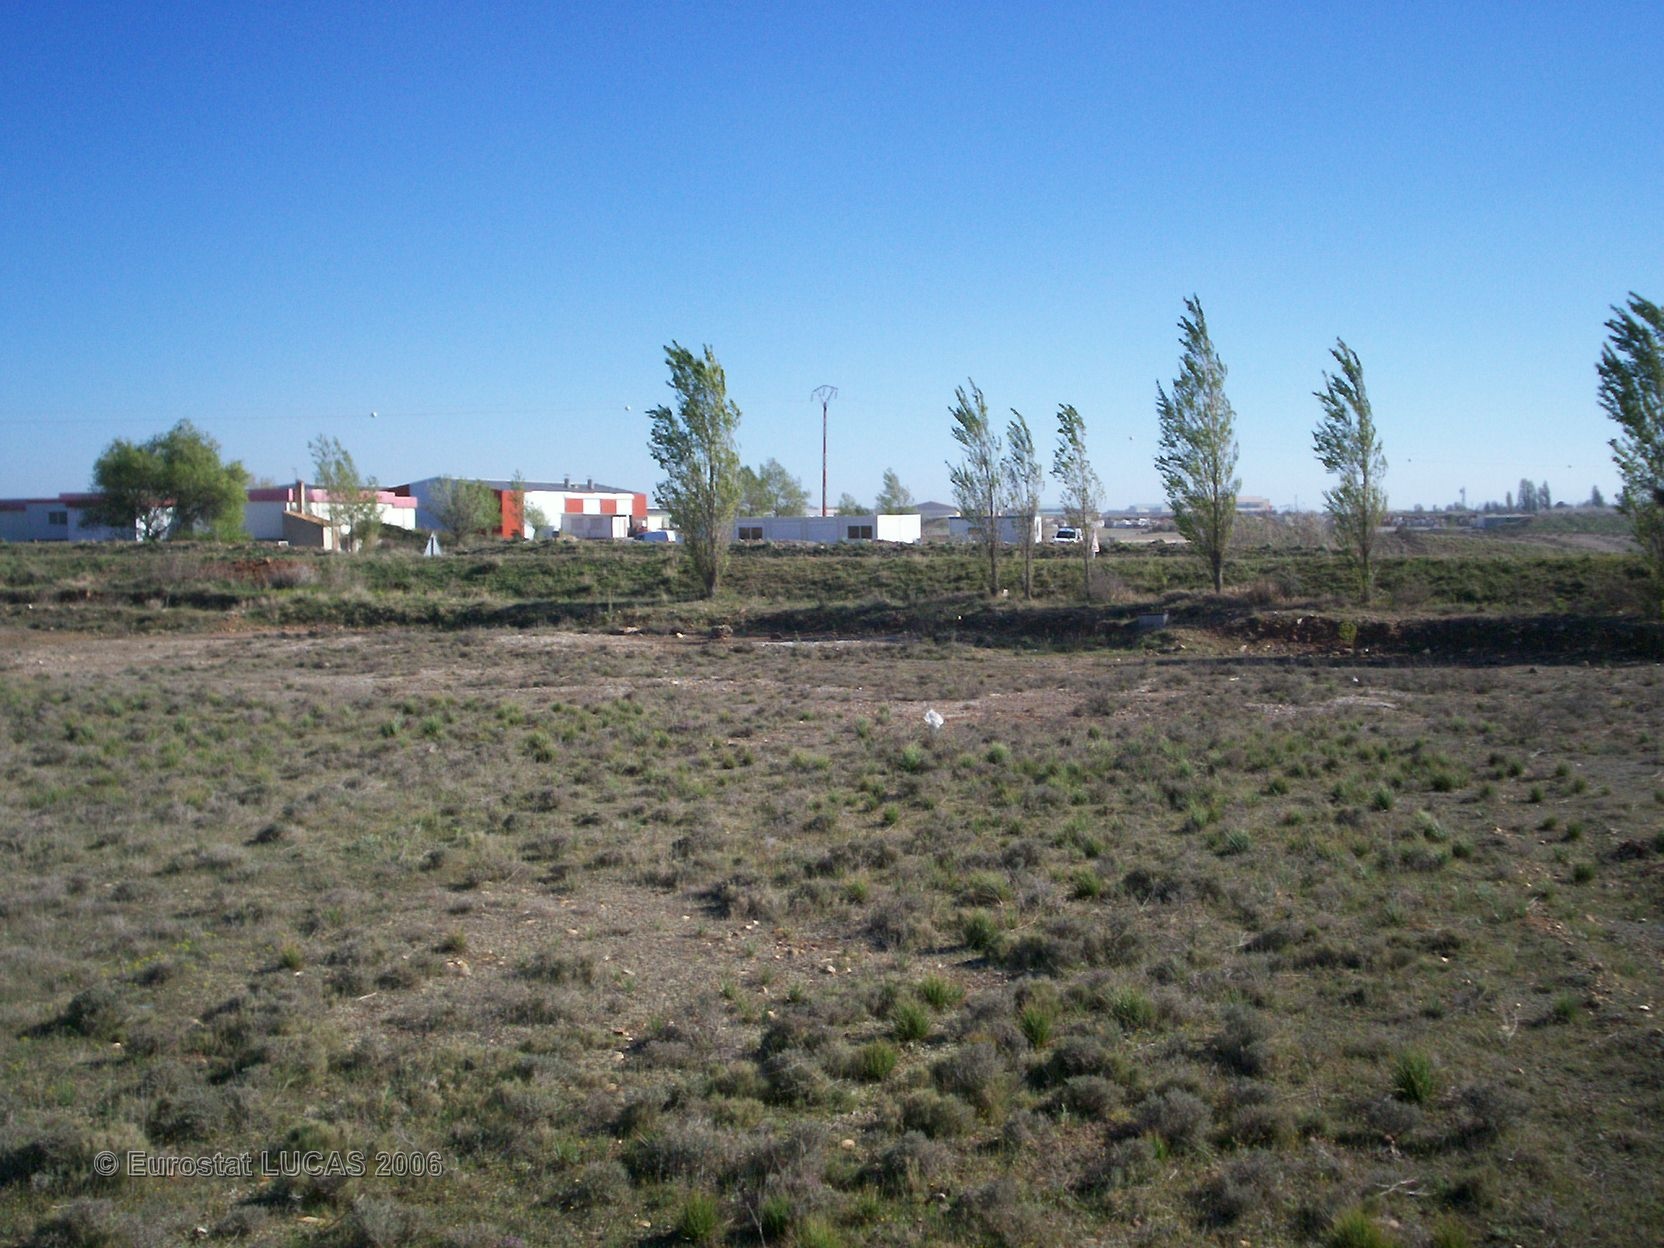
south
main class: Artificial land
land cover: Non built-up area features
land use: Logistics and storage
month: April
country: FR
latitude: 43.5408
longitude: 4.9481
